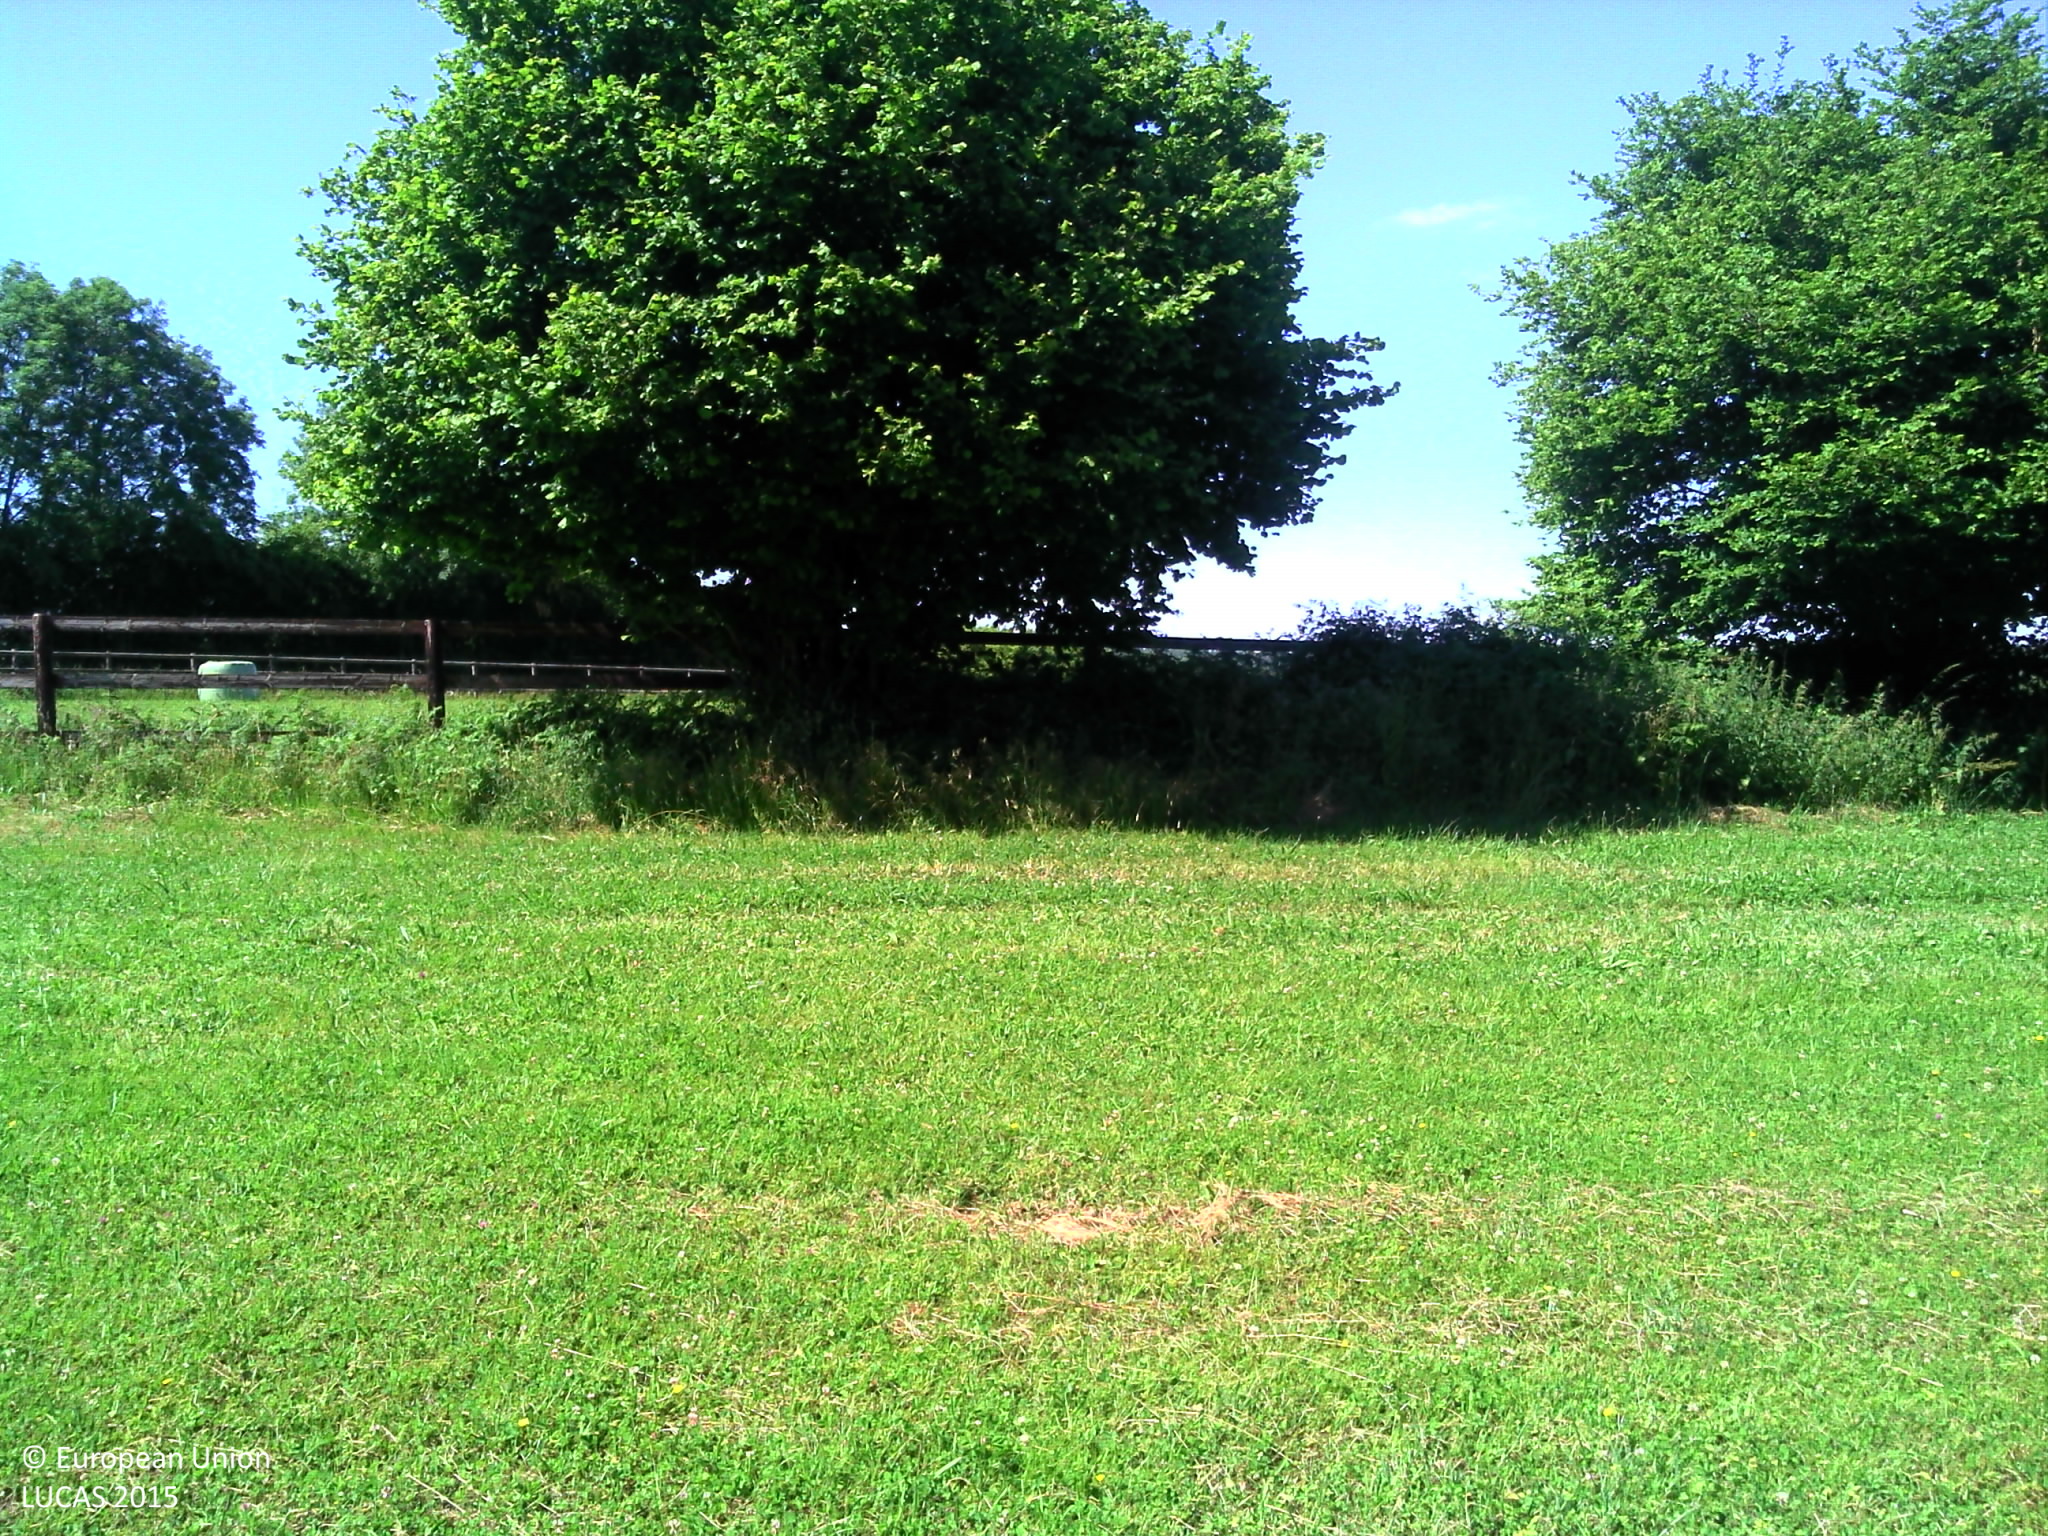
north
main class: Grassland
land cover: Grassland without tree/shrub cover
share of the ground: > 75 %
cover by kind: herbaceous plants 100 %
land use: Agriculture (excluding fallow land and kitchen gardens)
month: June
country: FR
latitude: 48.5558
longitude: 0.0943
